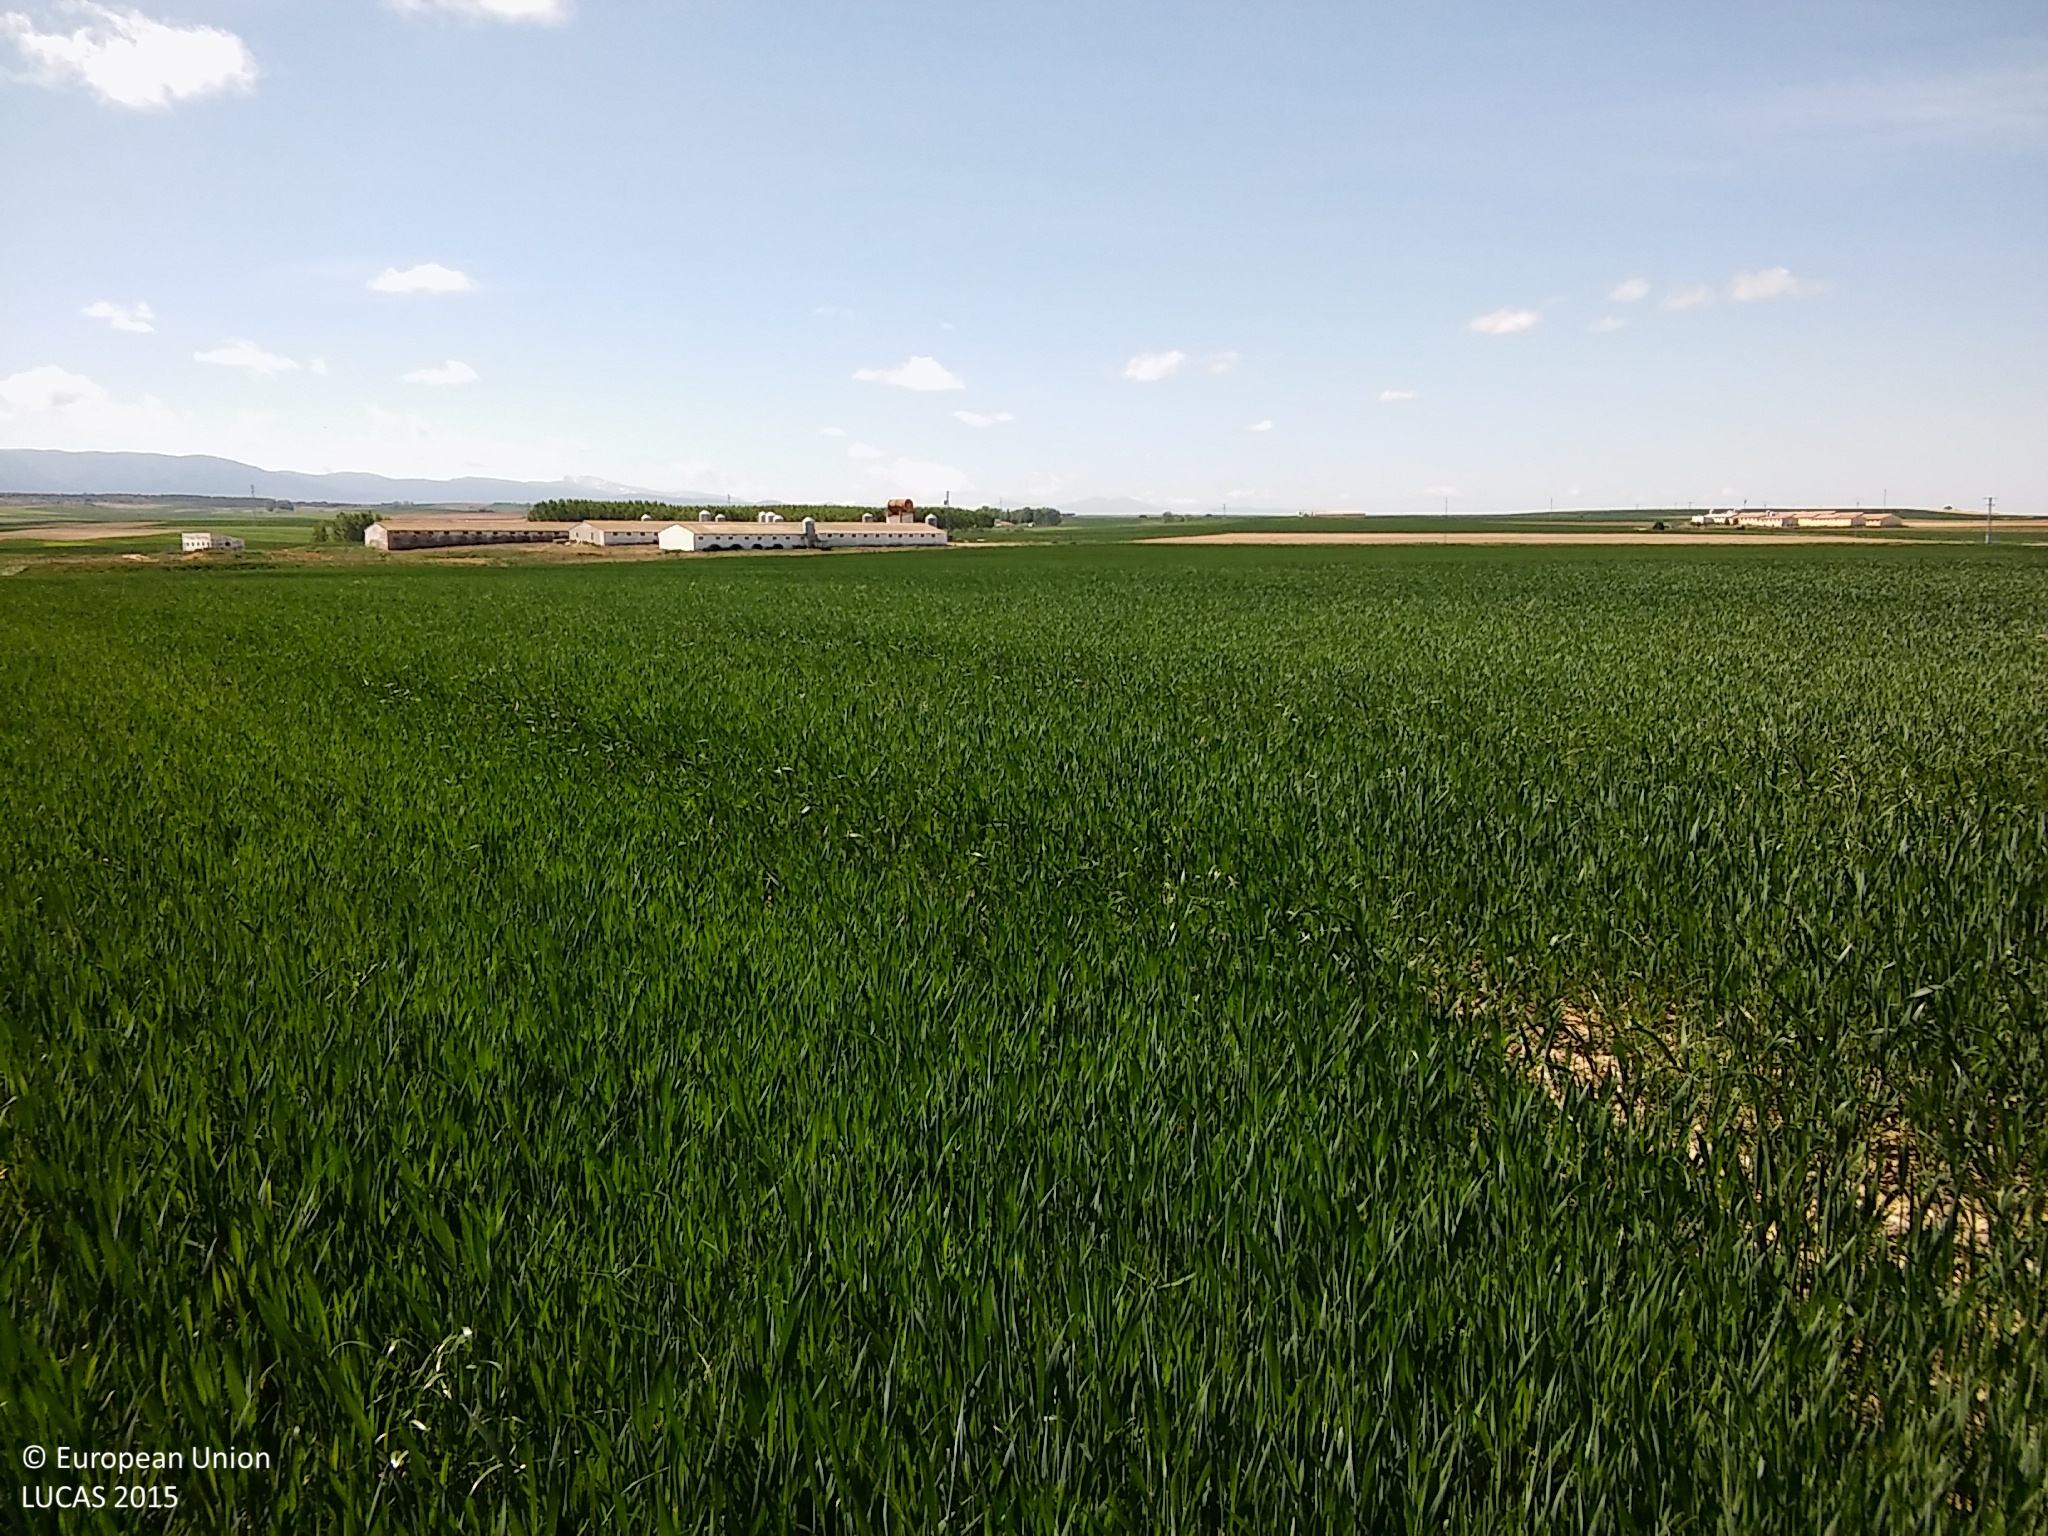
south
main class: Cropland
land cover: Common wheat
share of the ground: > 75 %
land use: Agriculture (excluding fallow land and kitchen gardens)
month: May
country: ES
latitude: 41.1870
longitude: -3.9643
